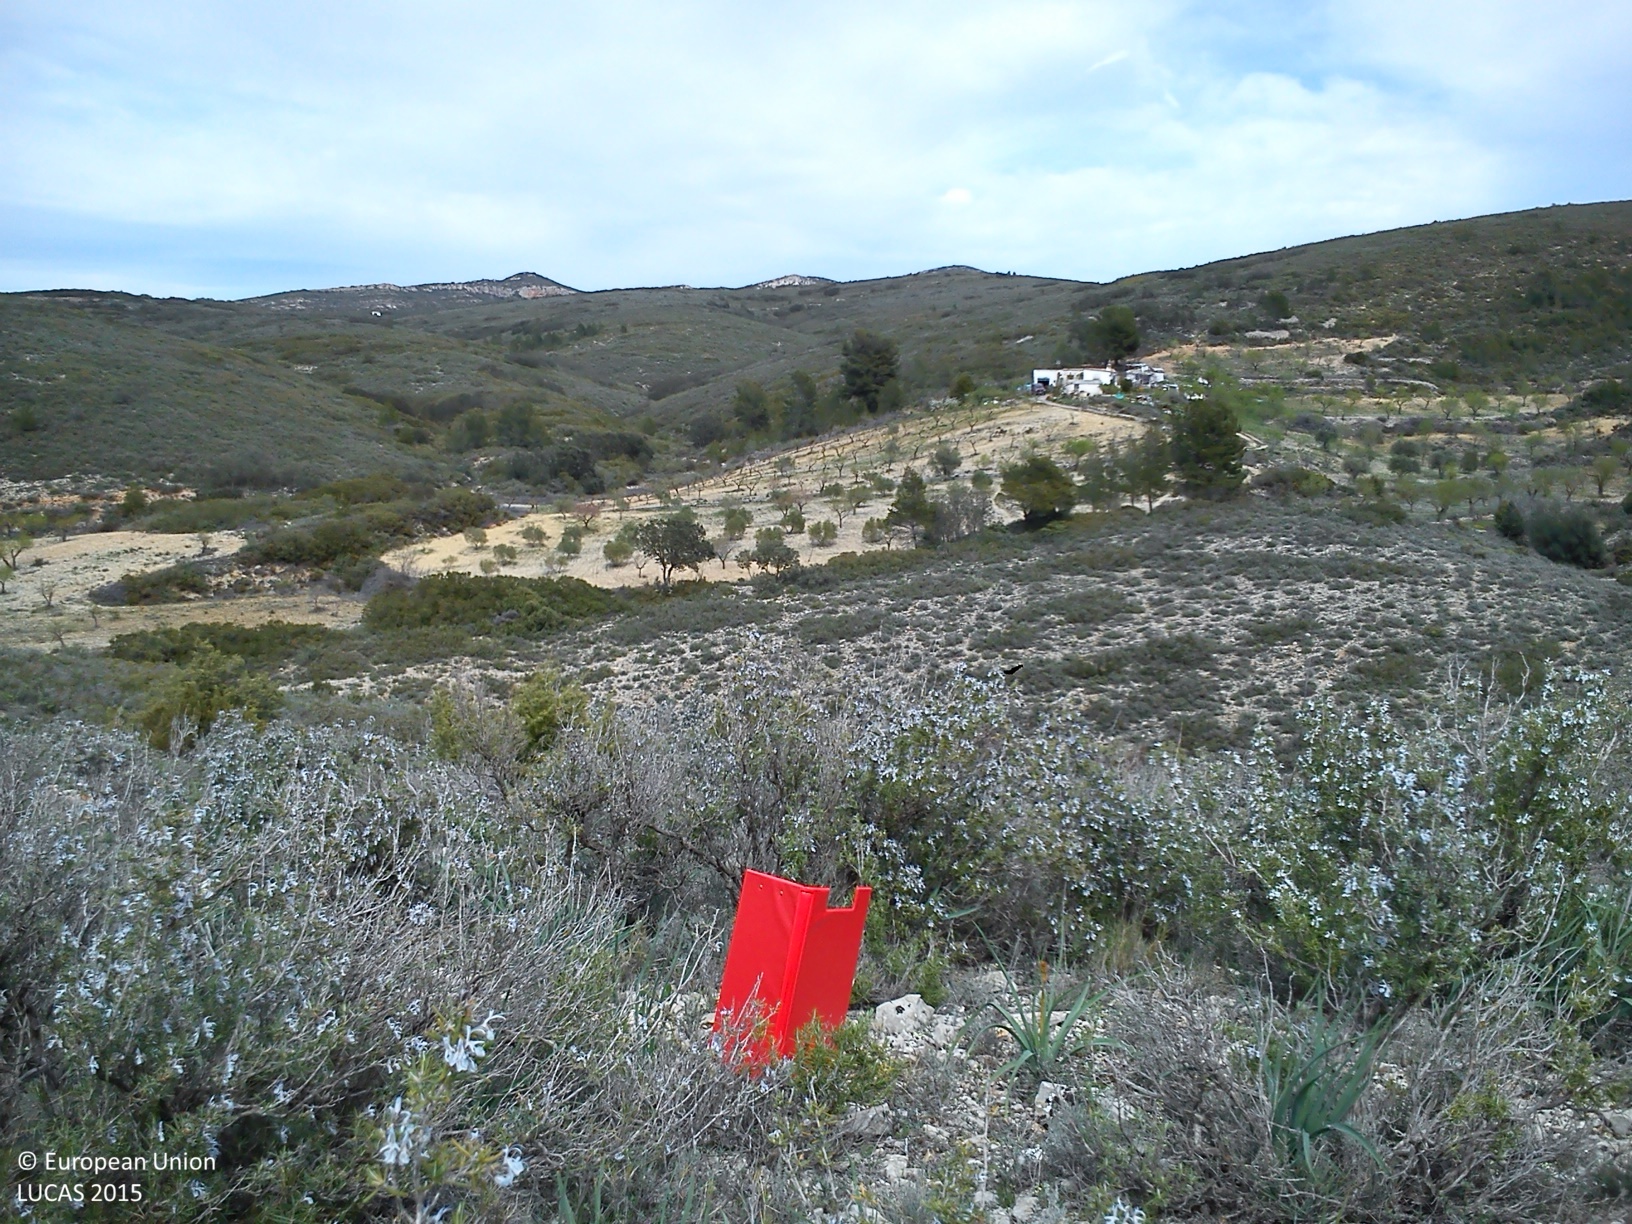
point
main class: Shrubland
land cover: Shrubland without tree cover
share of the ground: > 75 %
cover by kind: shrubs 40 %, consolidated bare surface 40 %, herbaceous plants 20 %
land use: Semi-natural and natural areas not in use
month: March
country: ES
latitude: 39.4944
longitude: -0.8956
